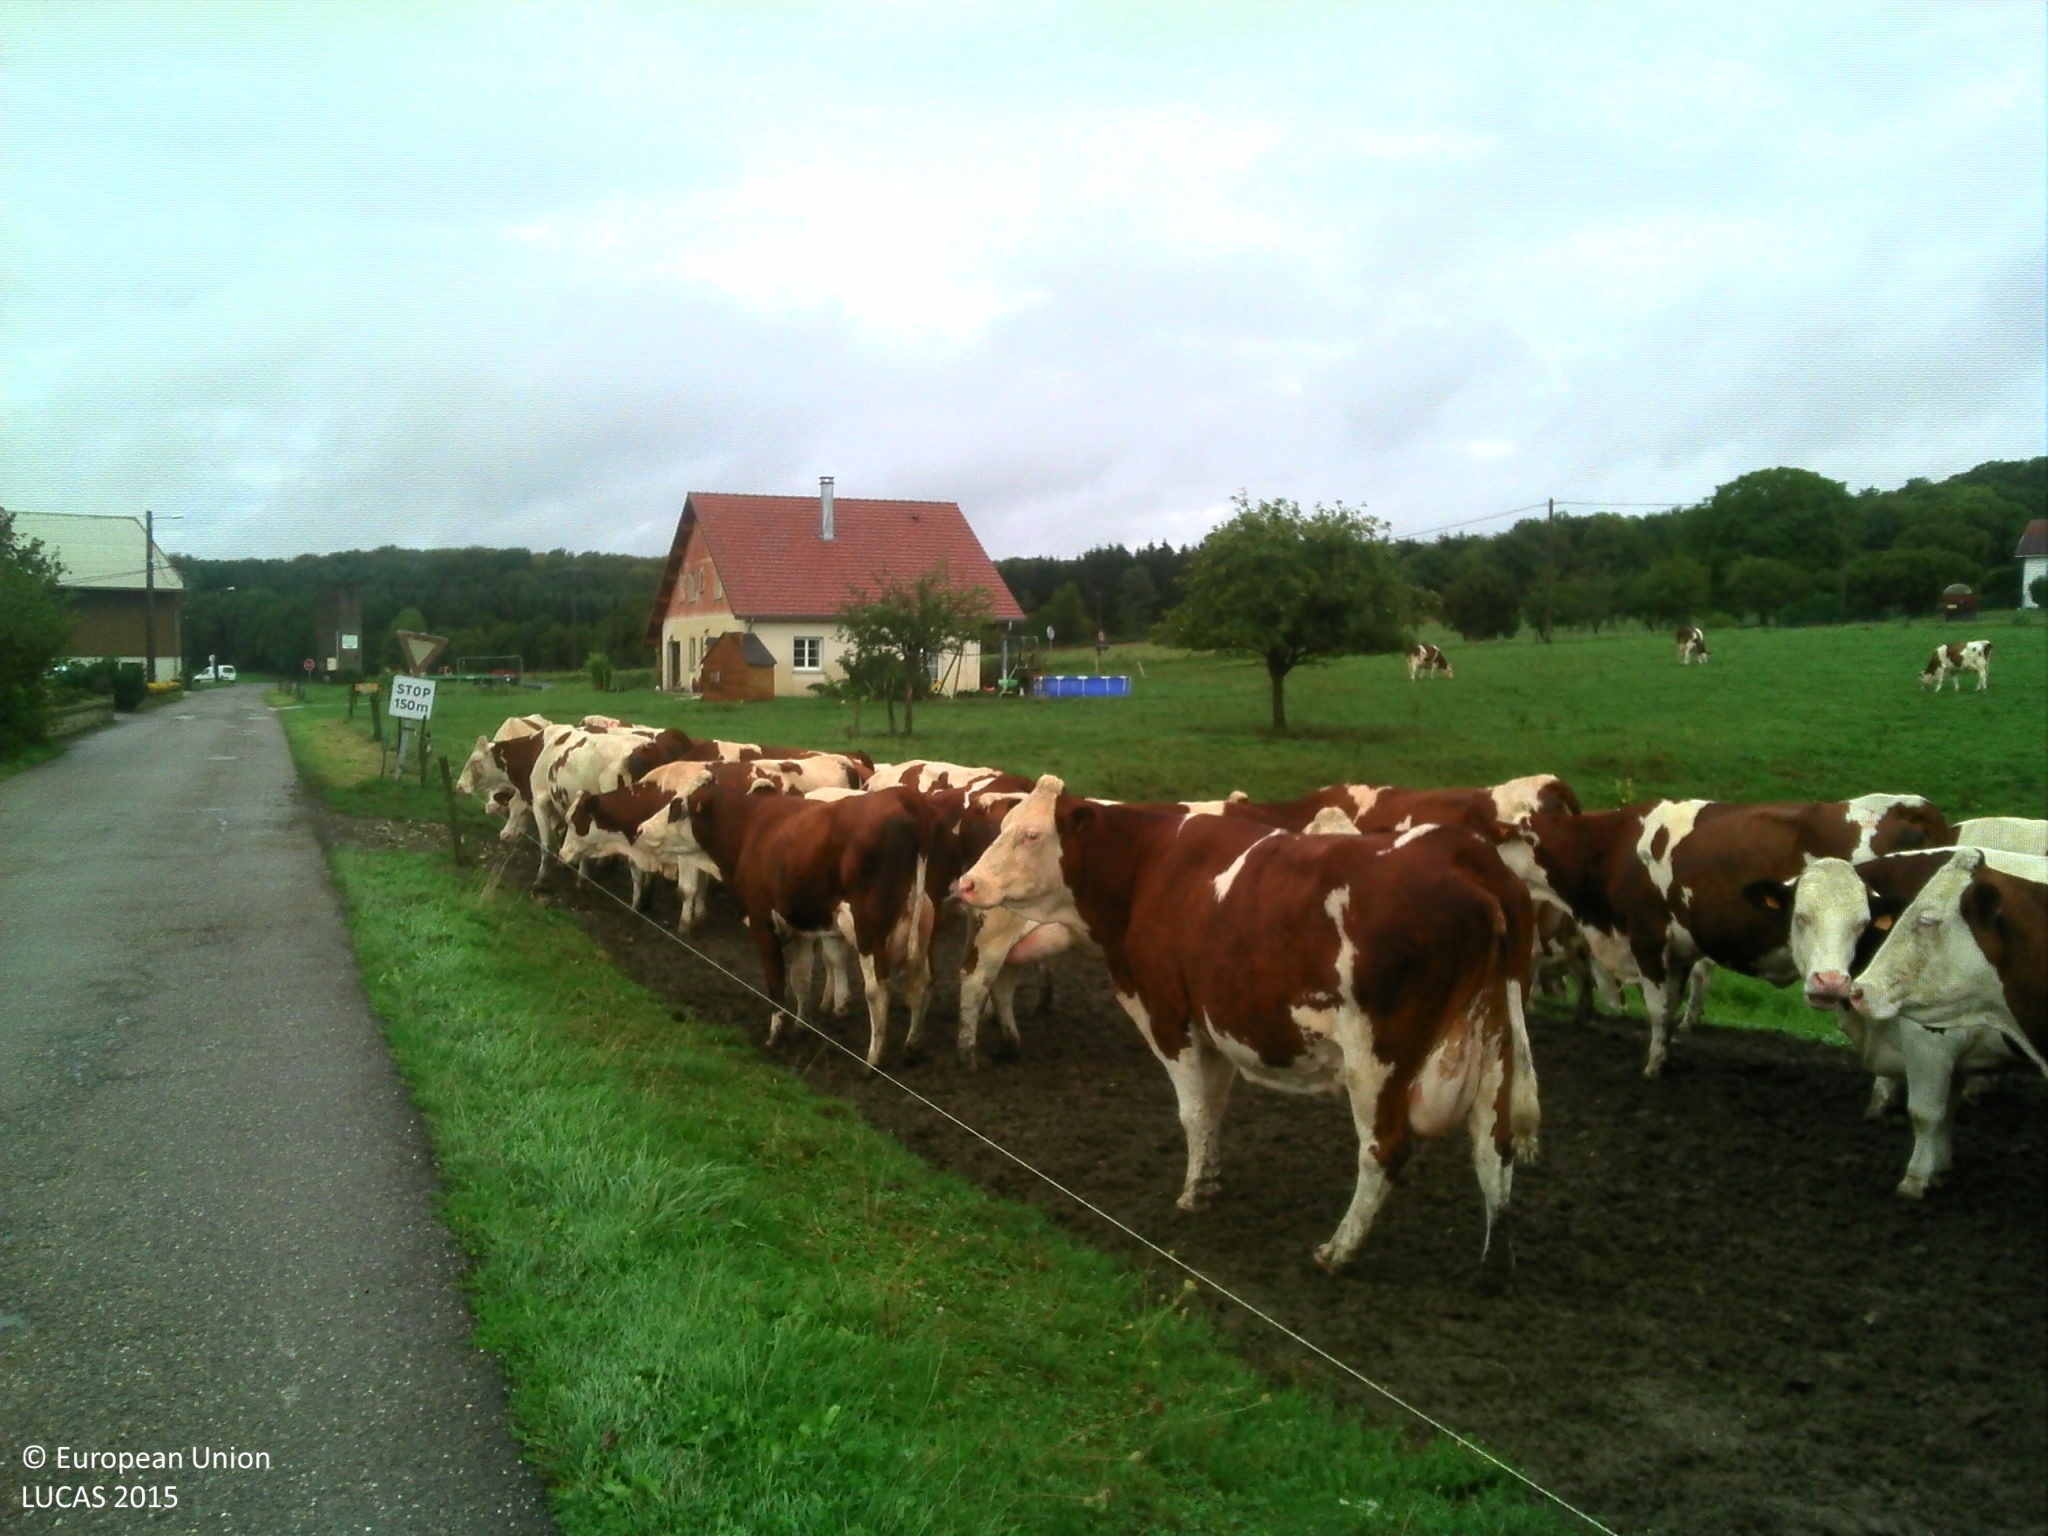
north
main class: Grassland
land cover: Grassland without tree/shrub cover
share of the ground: > 75 %
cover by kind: herbaceous plants 80 %, unconsolidated bare surface 20 %
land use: Agriculture (excluding fallow land and kitchen gardens)
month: September
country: FR
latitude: 47.1818
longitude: 6.1091
